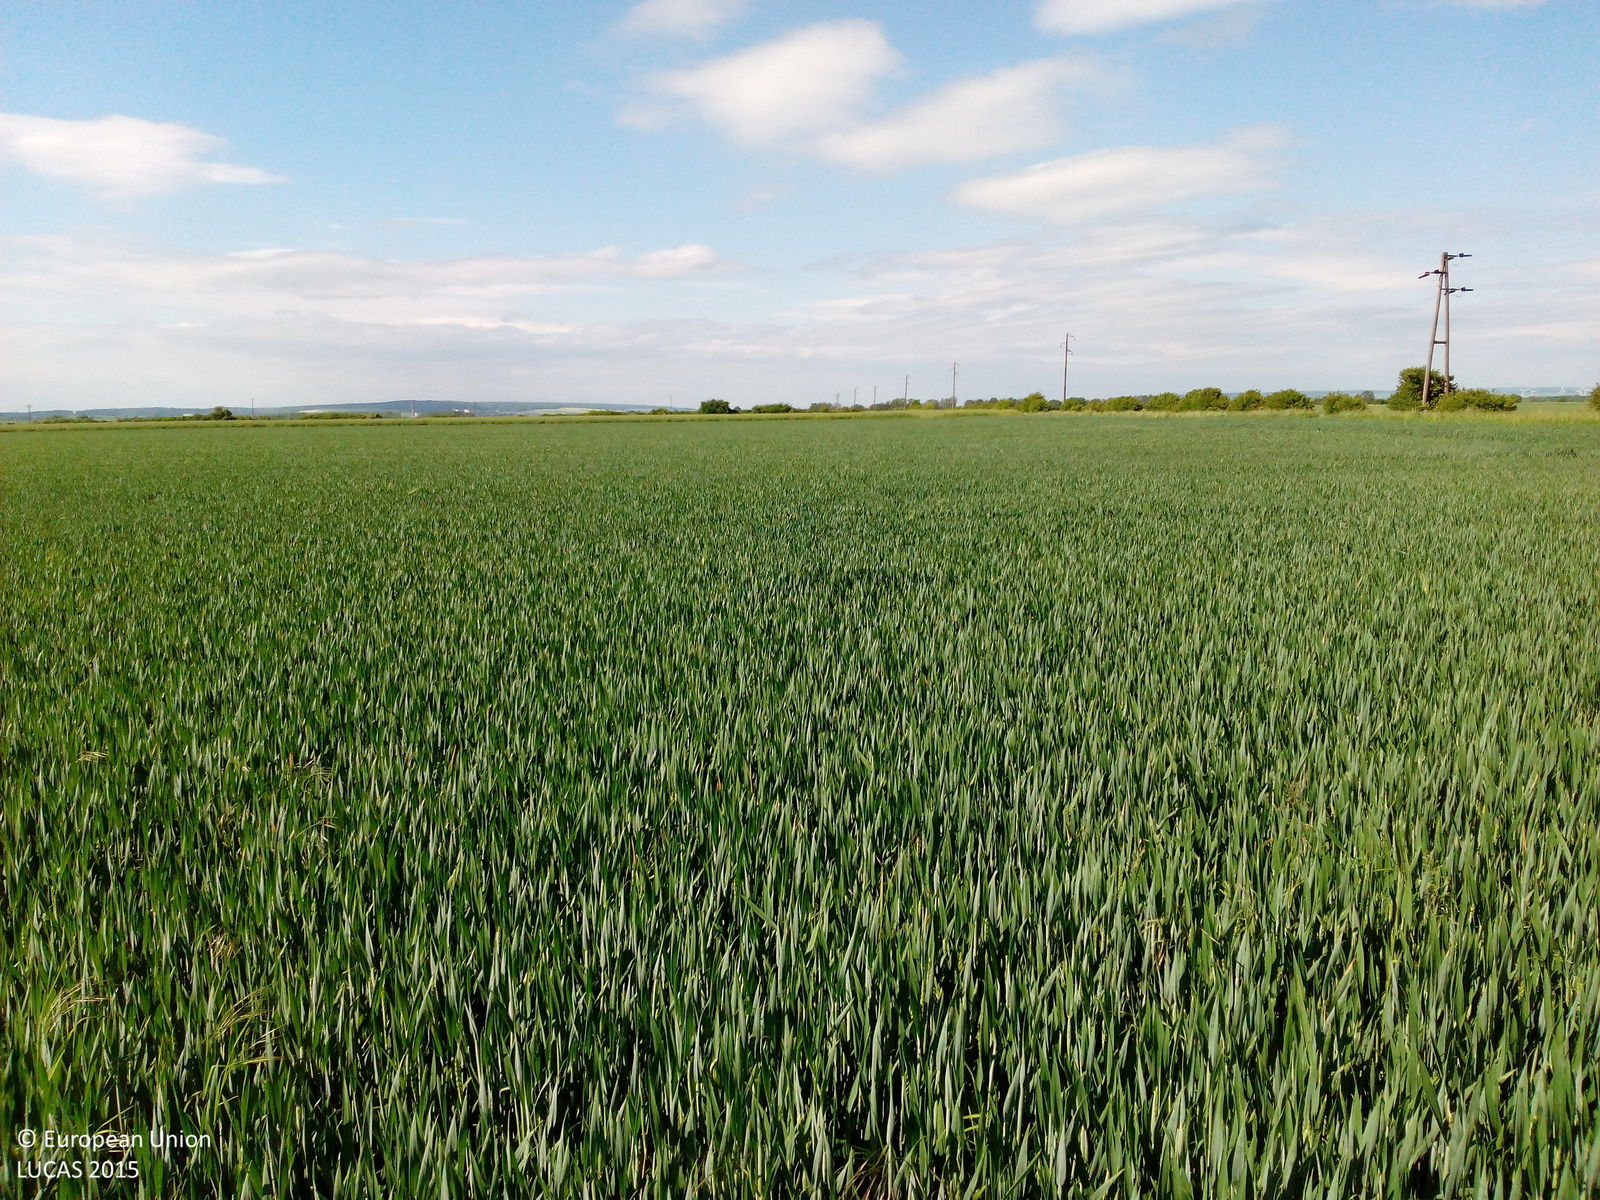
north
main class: Cropland
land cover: Common wheat
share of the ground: > 75 %
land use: Agriculture (excluding fallow land and kitchen gardens)
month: June
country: DE
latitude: 51.9807
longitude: 10.5676
